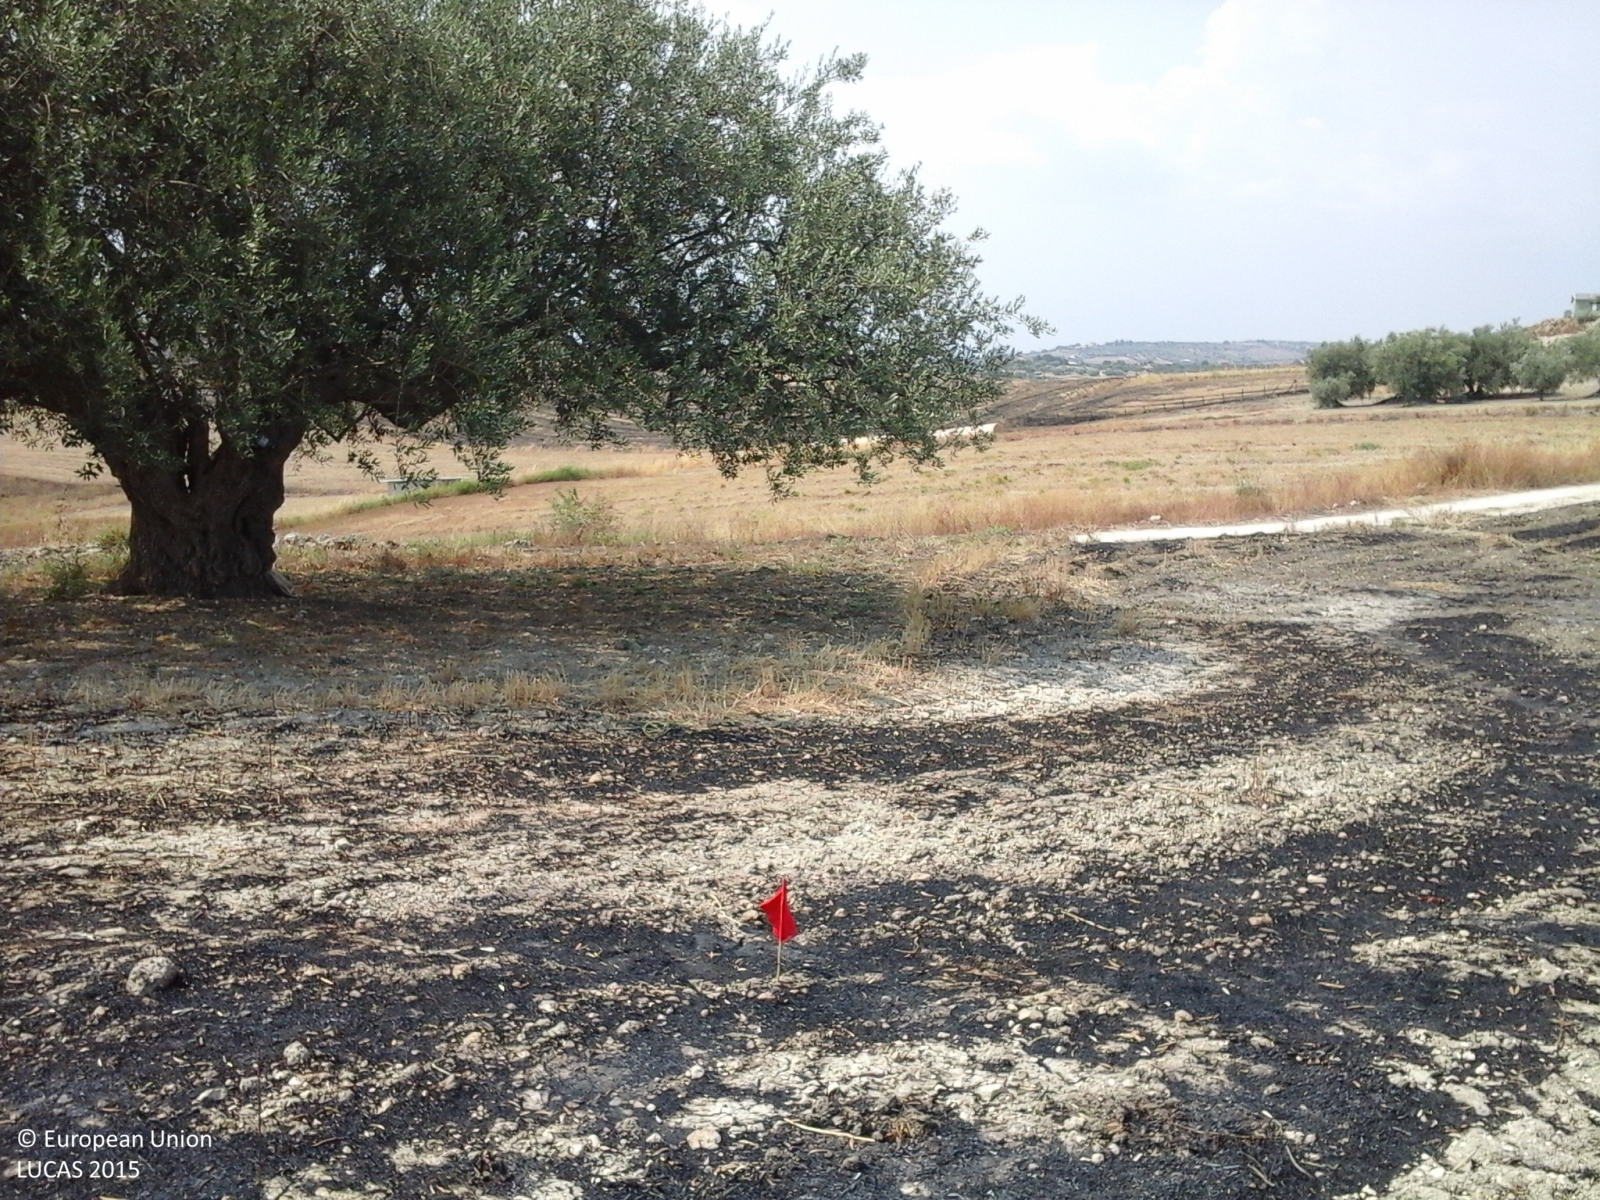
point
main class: Cropland
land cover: Durum wheat
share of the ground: > 75 %
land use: Agriculture (excluding fallow land and kitchen gardens)
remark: Burnt area
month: July
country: IT
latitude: 37.2475
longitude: 13.9489
